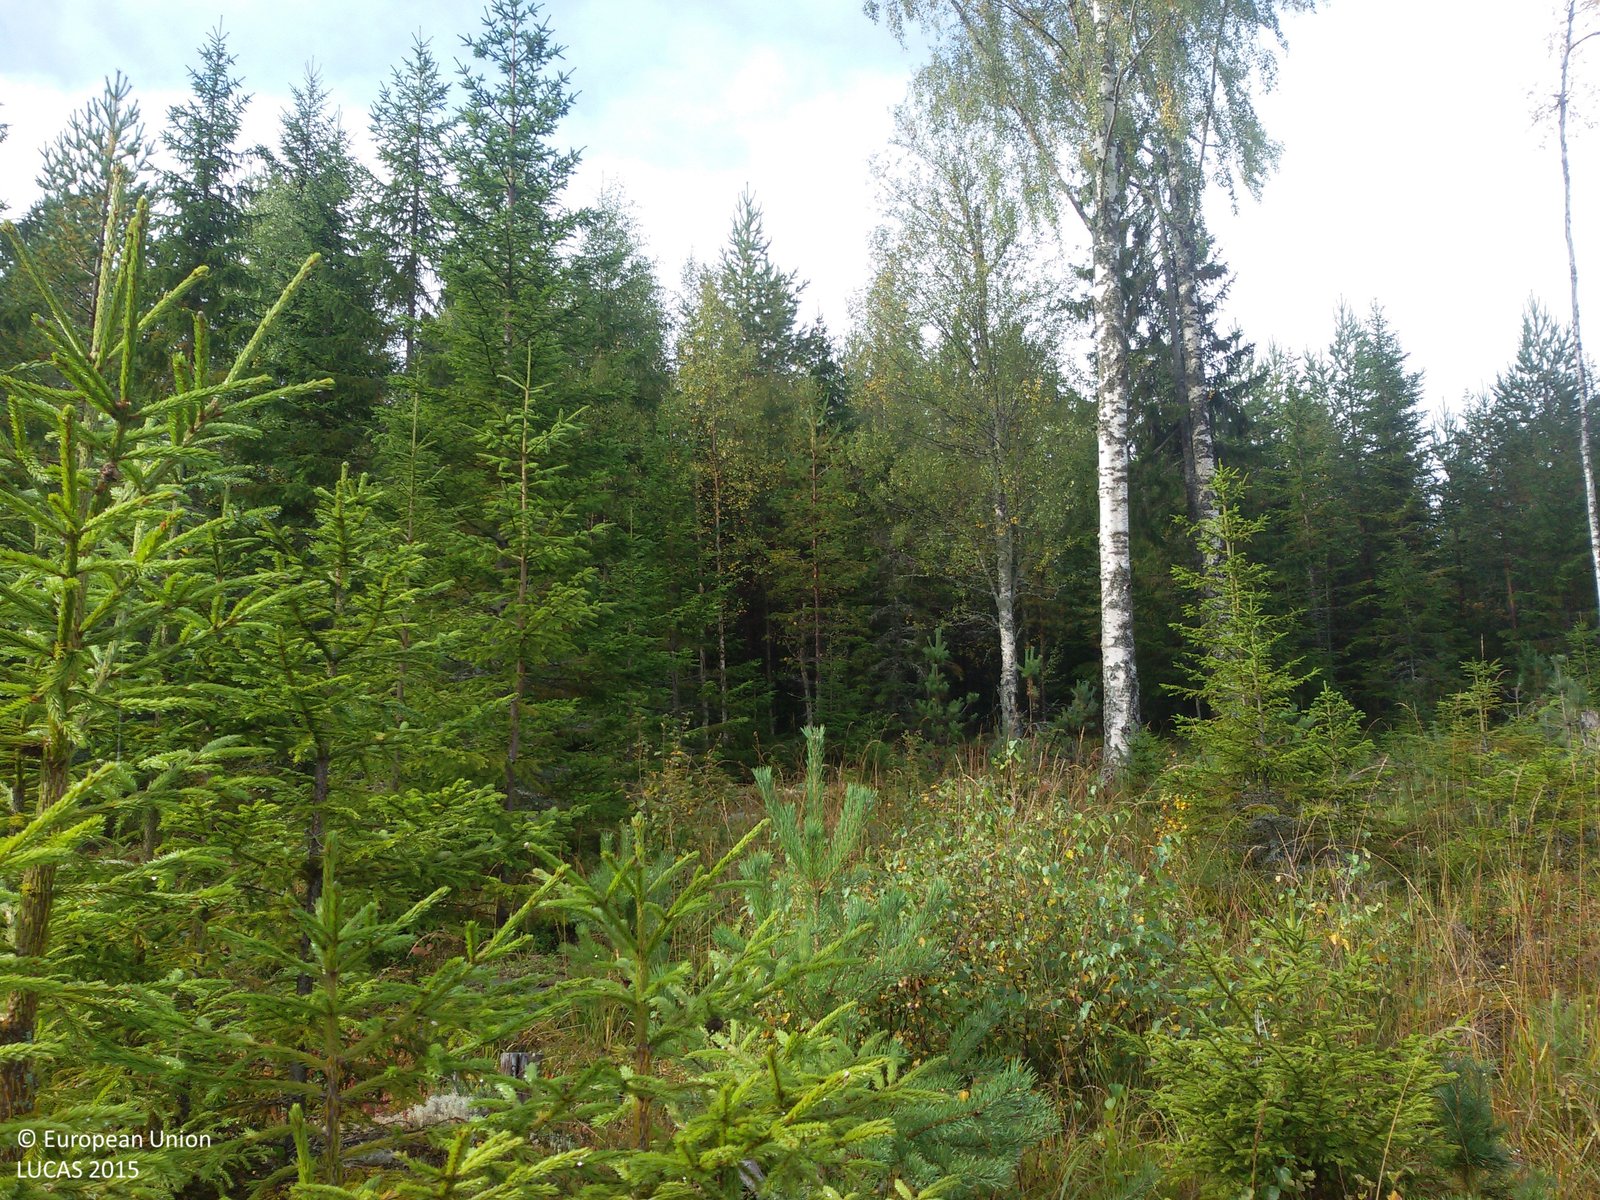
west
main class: Woodland
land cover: Spruce dominated mixed woodland
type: boreal forest
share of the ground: 50 - 75 %
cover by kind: coniferous forest trees 30 %, shrubs 30 %, broadleaved forest trees 20 %, herbaceous plants 20 %
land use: Forestry
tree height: < 5 m
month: September
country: SE
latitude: 60.8091
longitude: 14.6007
